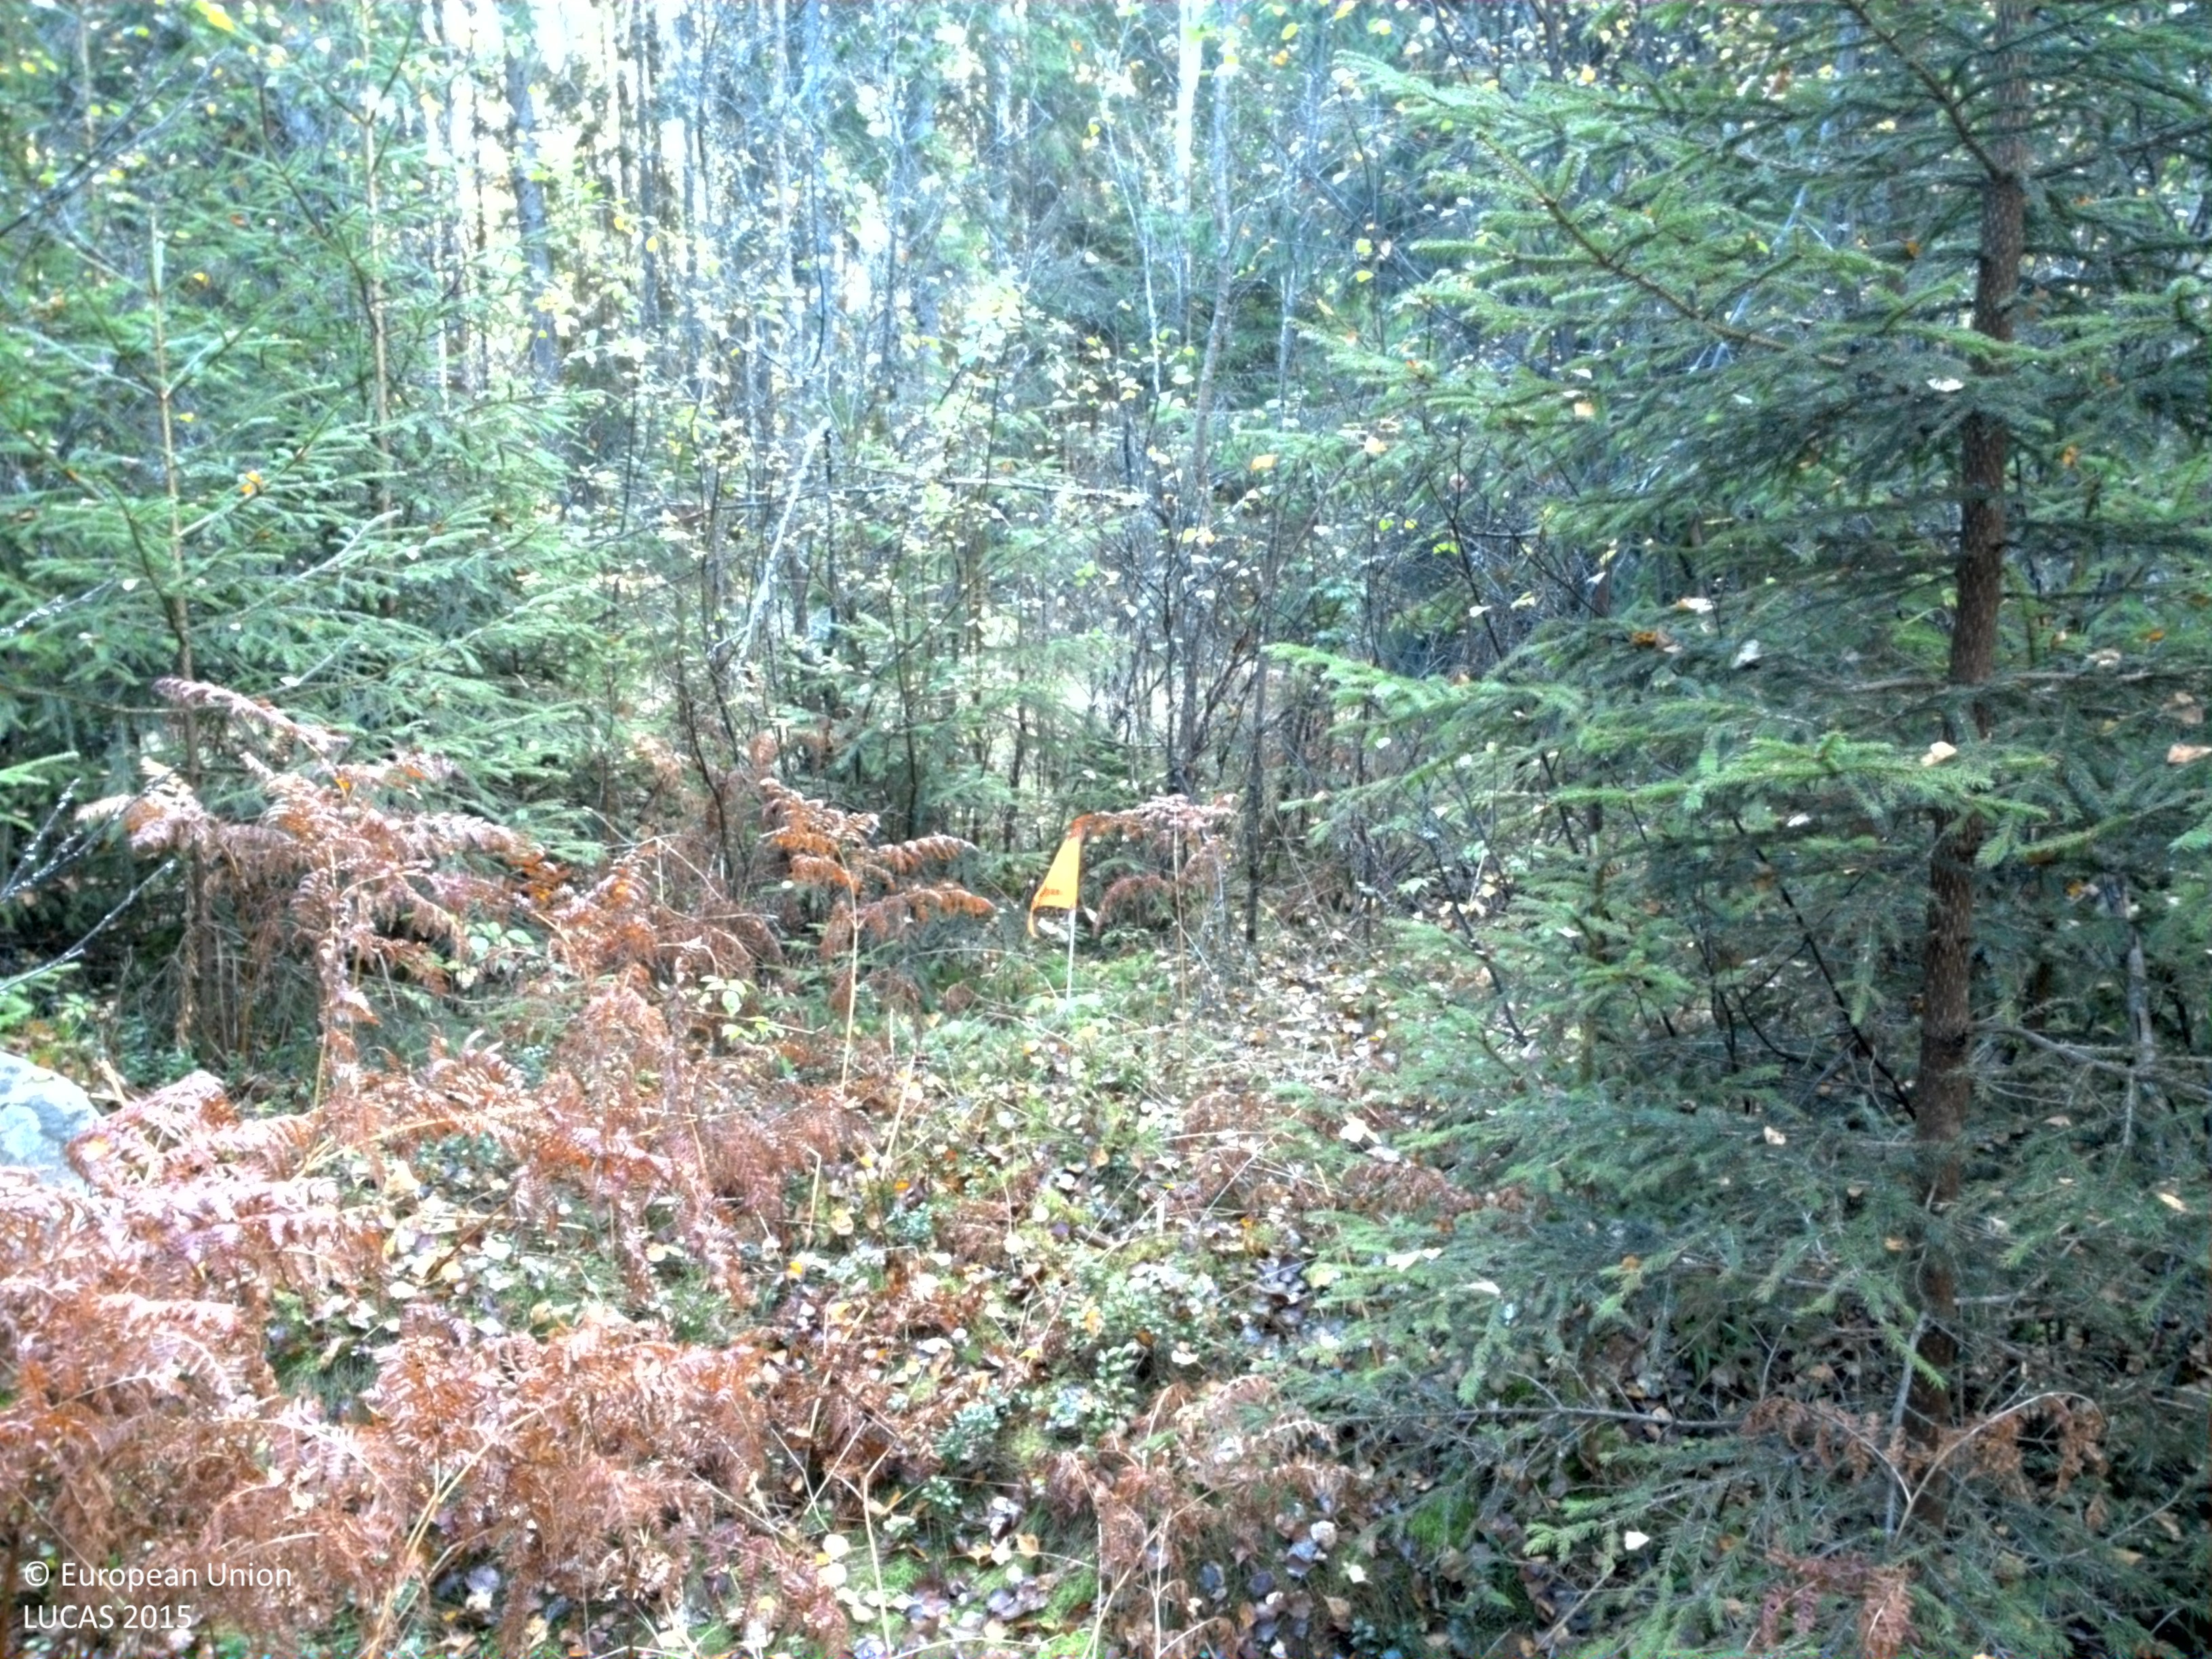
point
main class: Woodland
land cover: Spruce dominated mixed woodland
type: boreal forest
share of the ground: 50 - 75 %
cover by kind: coniferous forest trees 30 %, broadleaved forest trees 30 %, herbaceous plants 15 %, lichens and mosses 15 %, shrubs 10 %
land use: Forestry
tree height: > 5 m
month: September
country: SE
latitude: 59.2007
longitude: 14.1417
